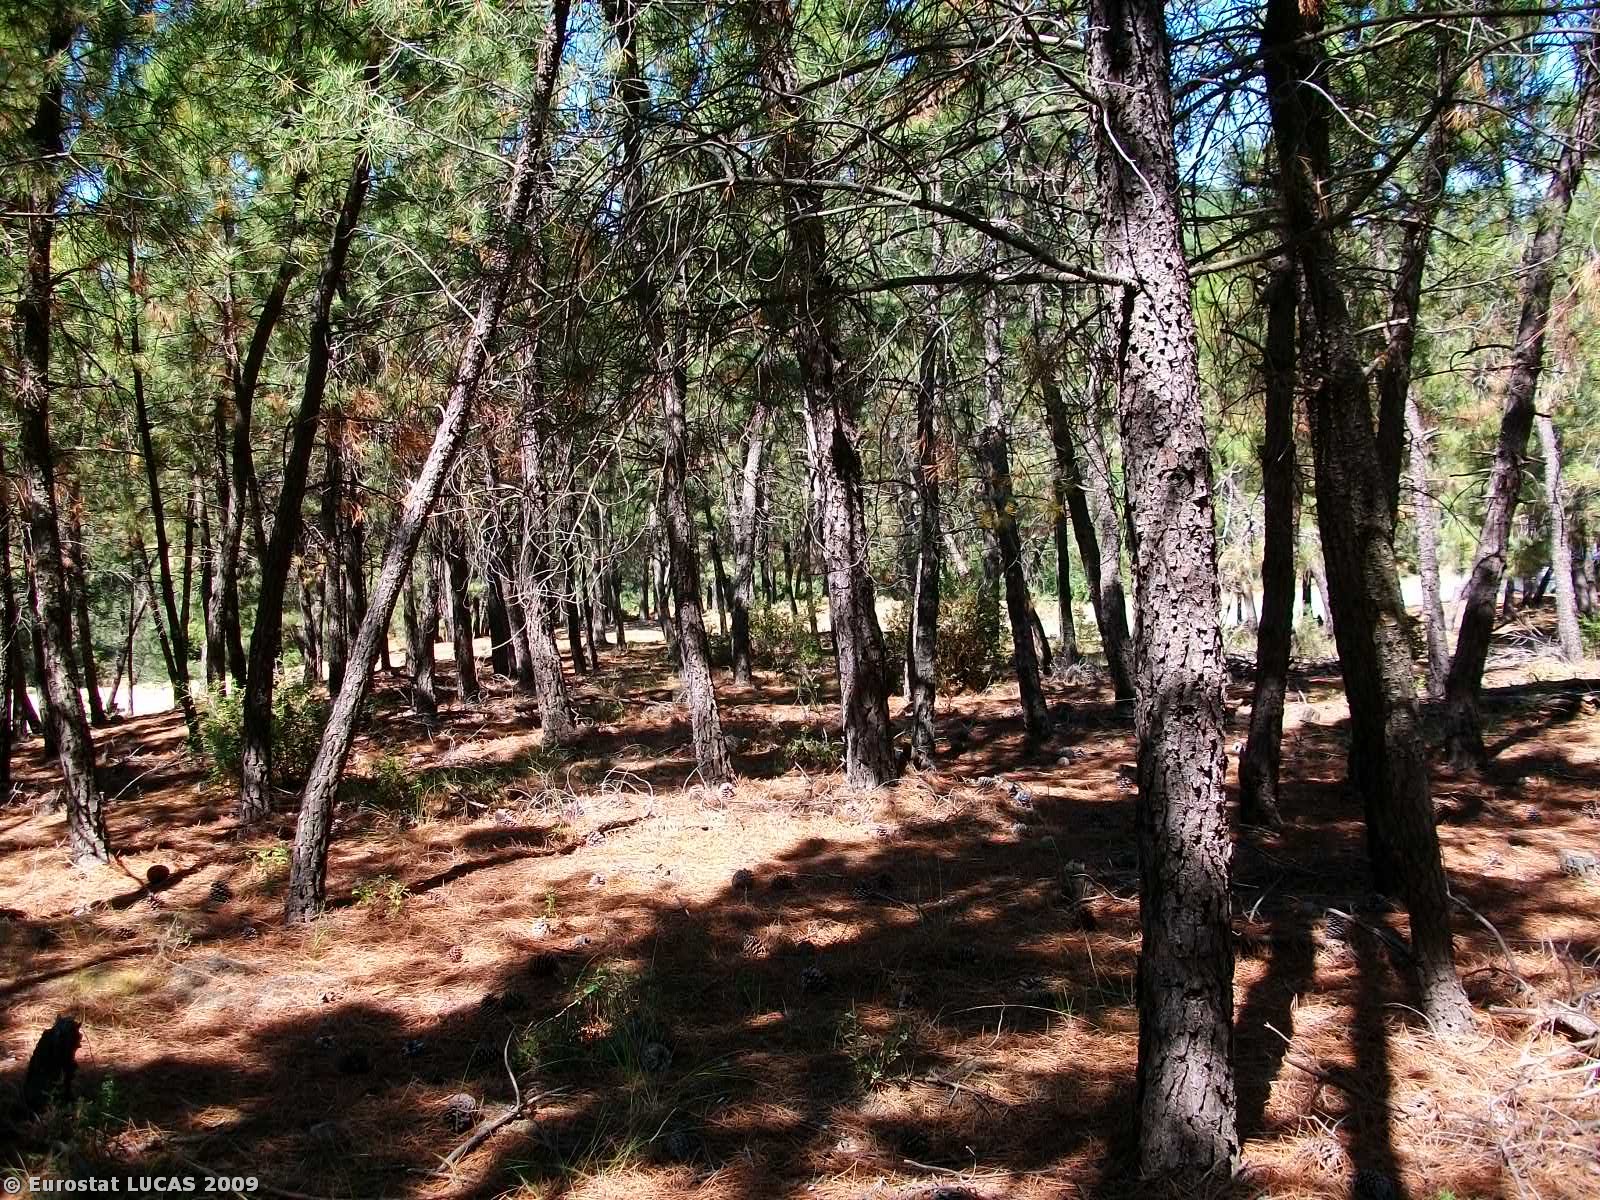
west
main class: Woodland
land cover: Coniferous woodland
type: coniferous forest of the mediterranean region
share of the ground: > 75 %
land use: Forestry
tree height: > 5 m
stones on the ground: < 10 %
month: June
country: GR
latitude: 40.9769
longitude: 25.4880
